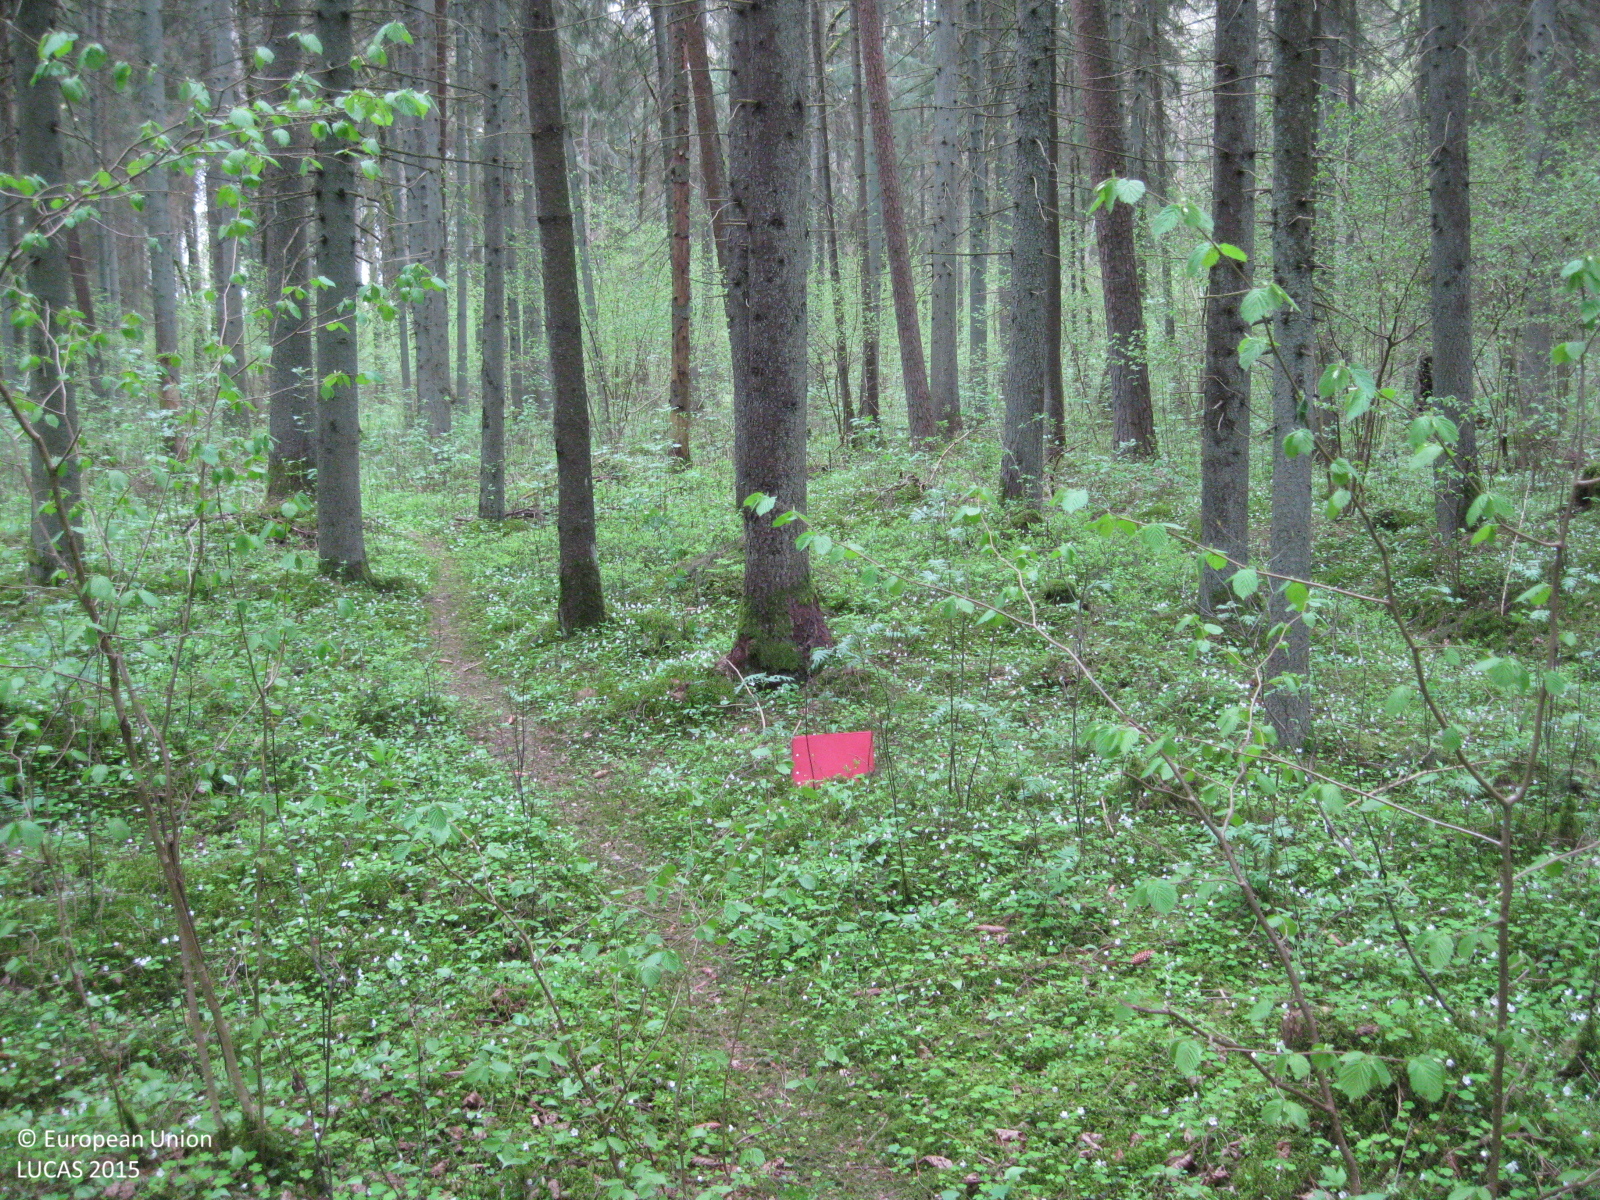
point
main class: Woodland
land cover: Spruce dominated coniferous woodland
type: hemiboreal forest and nemoral coniferous forest and mixed broadleaved-coniferous forest
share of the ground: > 75 %
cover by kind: coniferous forest trees 75 %, lichens and mosses 10 %, broadleaved forest trees 5 %, shrubs 5 %, herbaceous plants 5 %
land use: Forestry
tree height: > 5 m
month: May
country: LT
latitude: 56.1519
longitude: 24.4395
